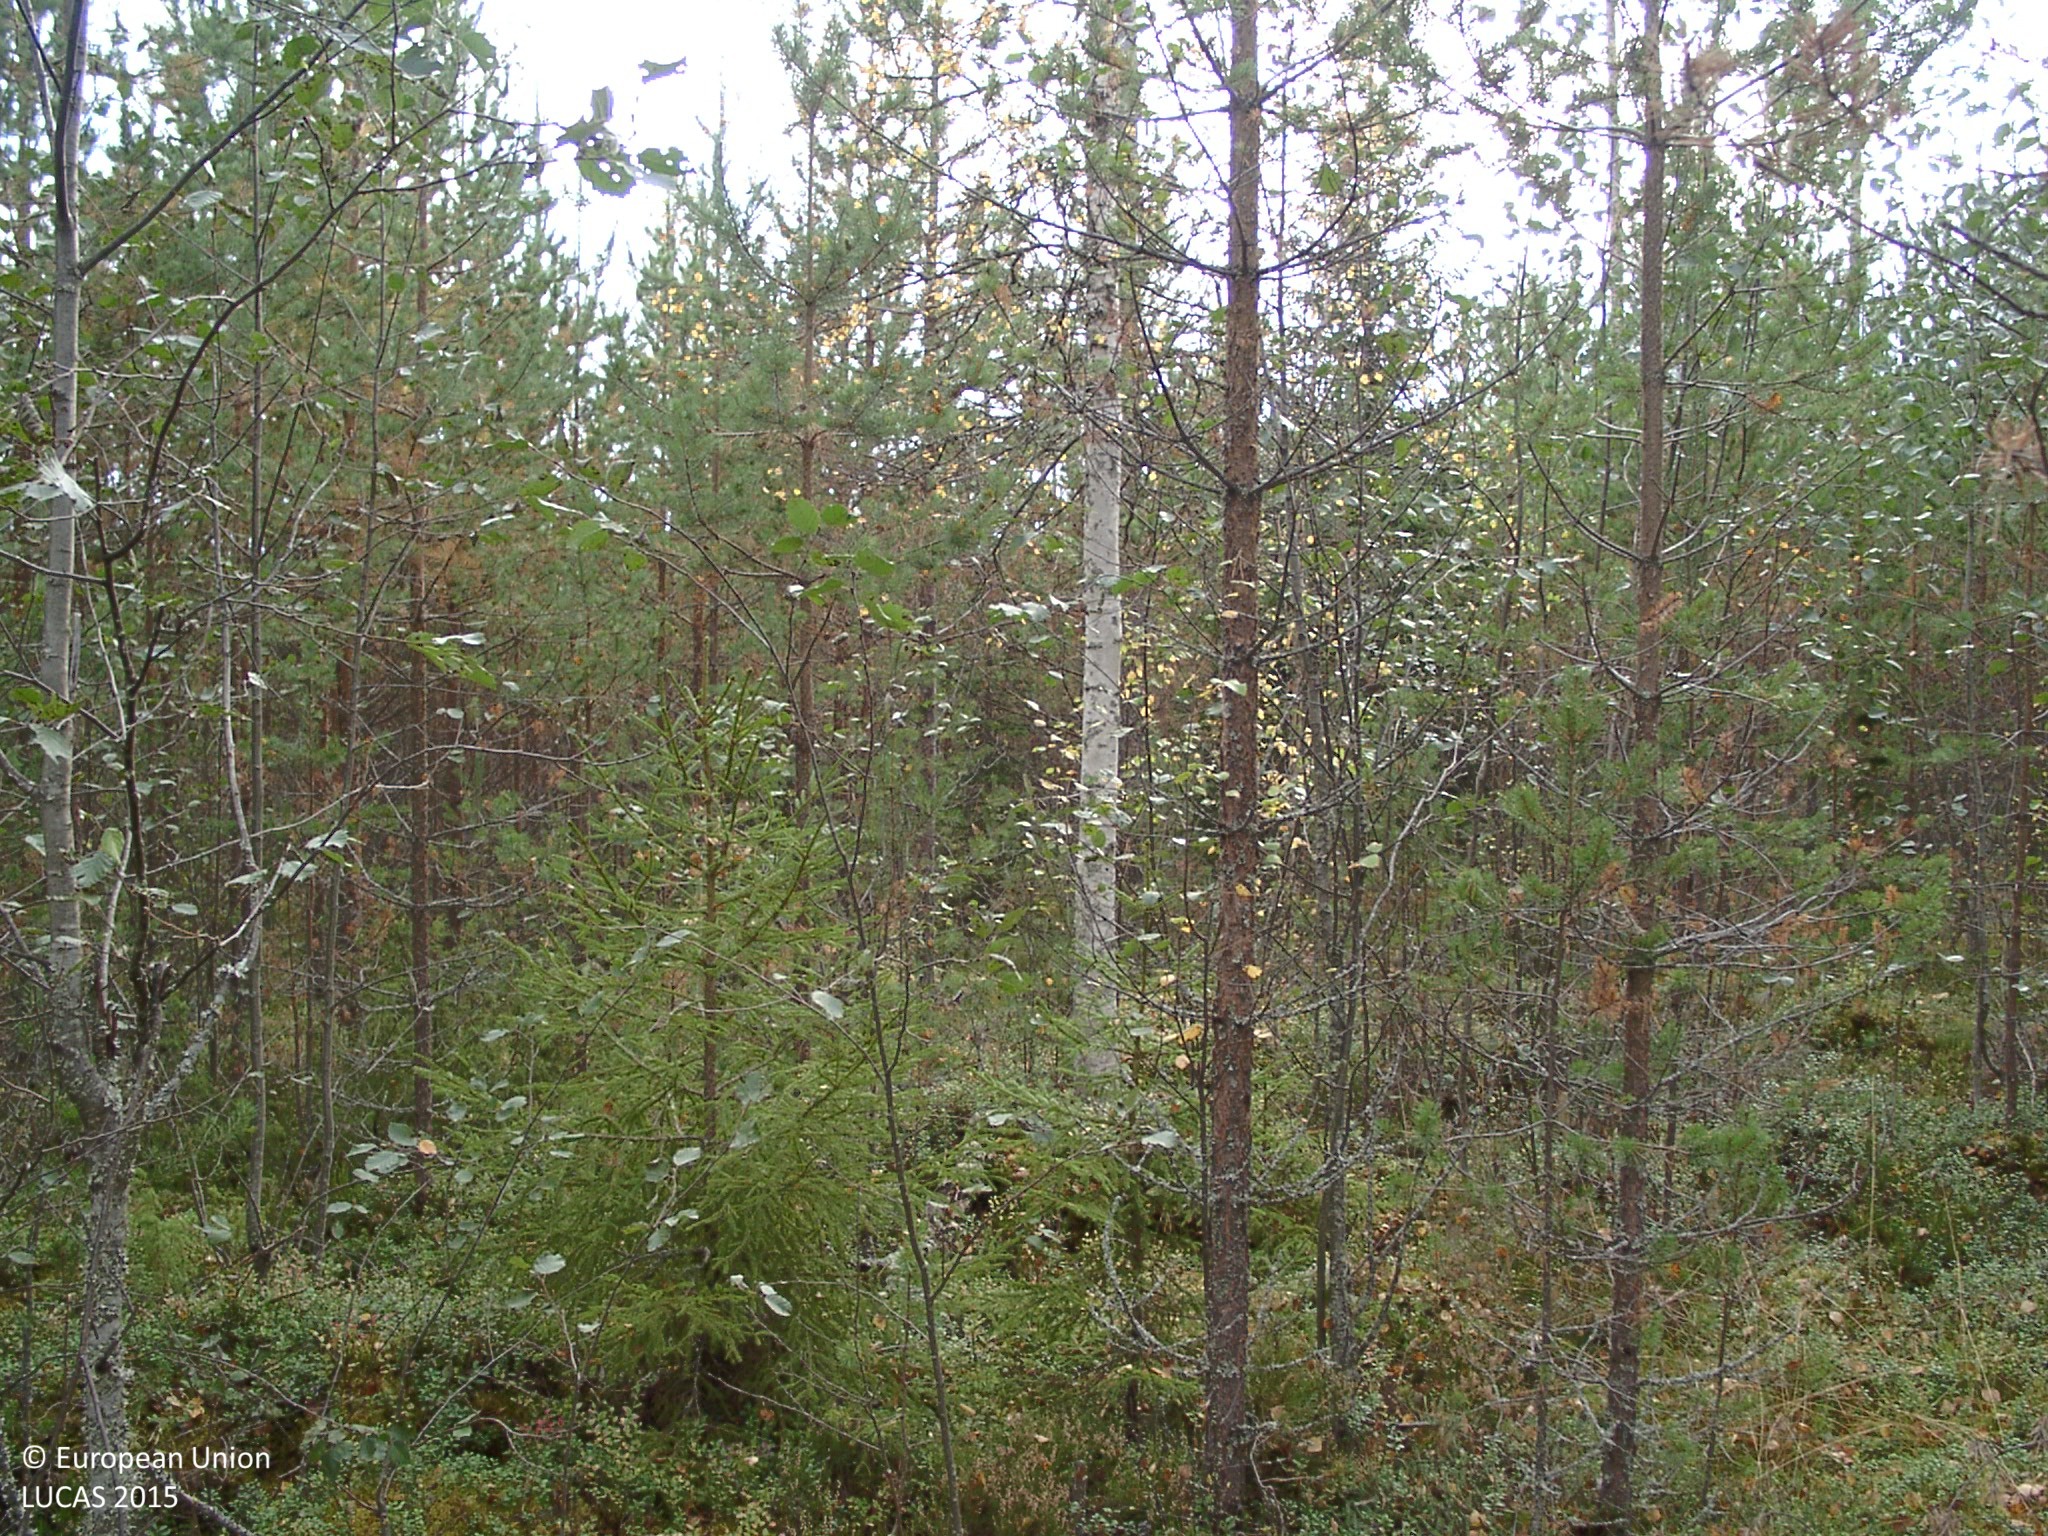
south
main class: Woodland
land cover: Pine dominated mixed woodland
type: boreal forest
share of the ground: 50 - 75 %
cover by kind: coniferous forest trees 45 %, shrubs 20 %, lichens and mosses 20 %, broadleaved forest trees 15 %
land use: Forestry
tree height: < 5 m
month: September
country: FI
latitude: 62.6759
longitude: 25.4377
